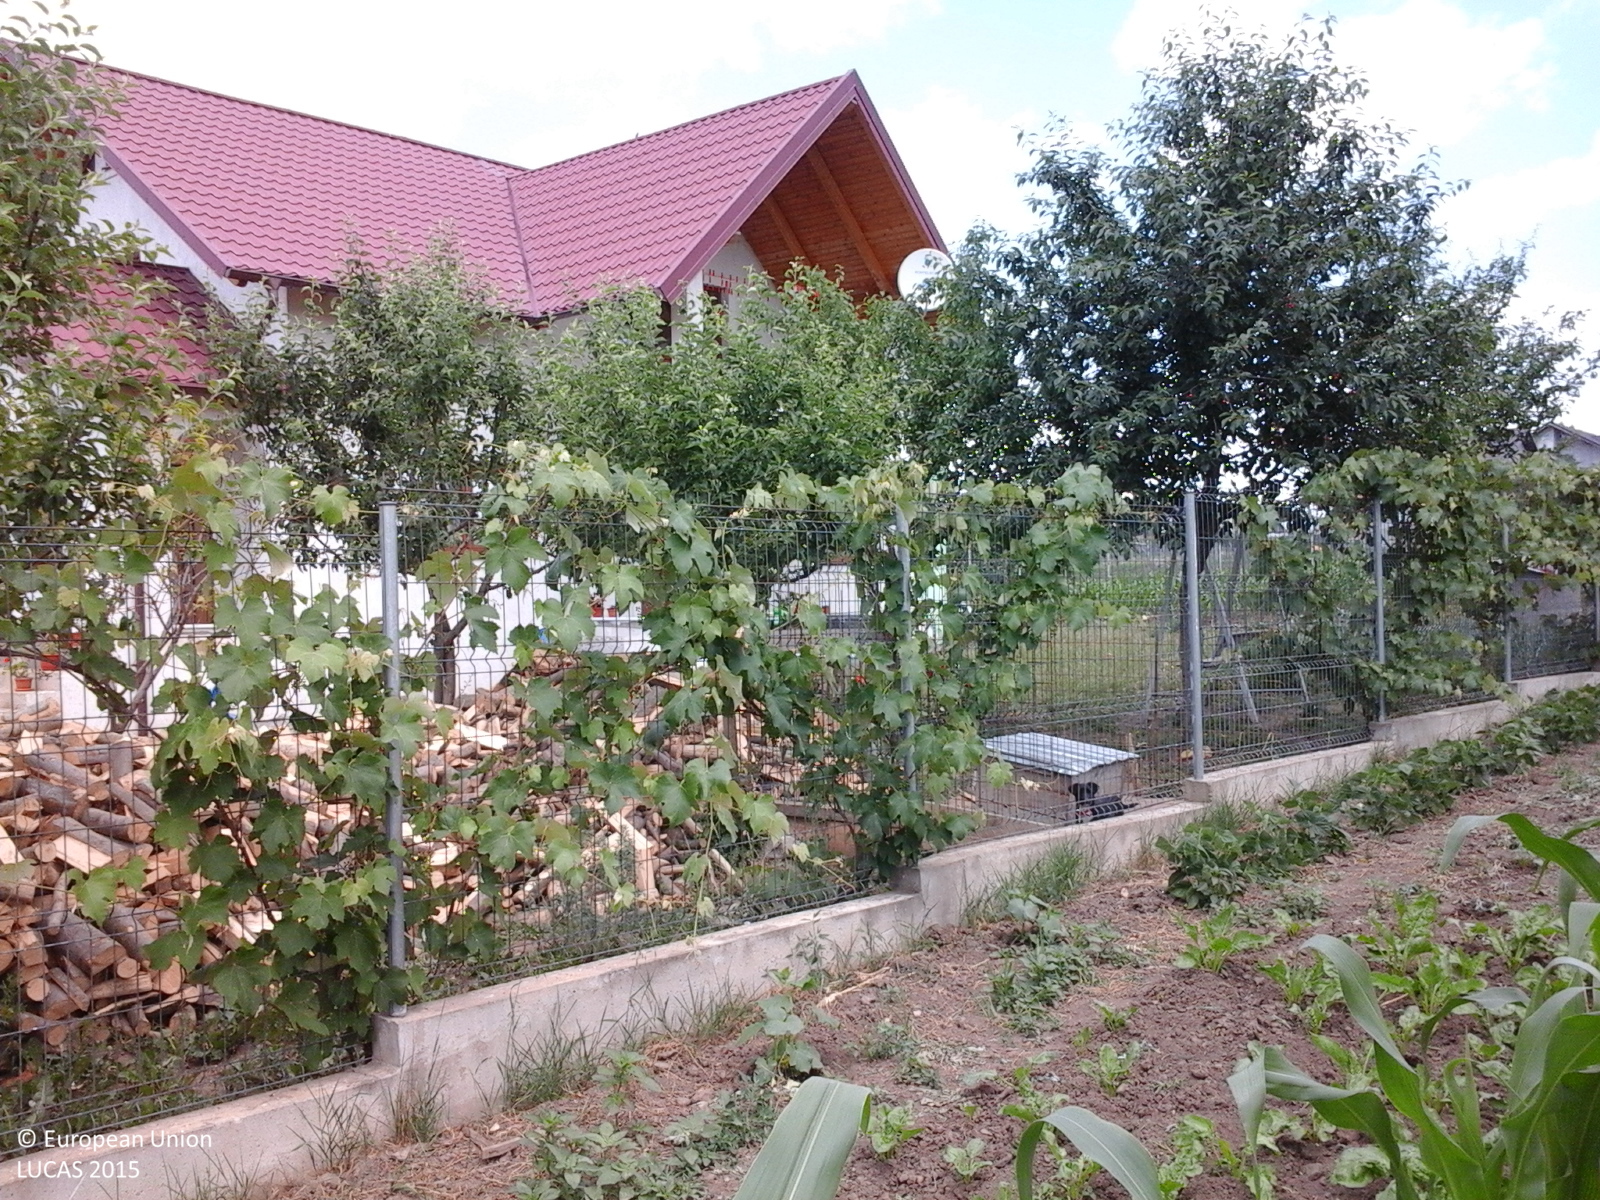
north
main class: Cropland
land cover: Maize
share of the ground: 50 - 75 %
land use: Agriculture (excluding fallow land and kitchen gardens)
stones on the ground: < 10 %
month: June
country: RO
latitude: 47.6539
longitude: 26.3420
